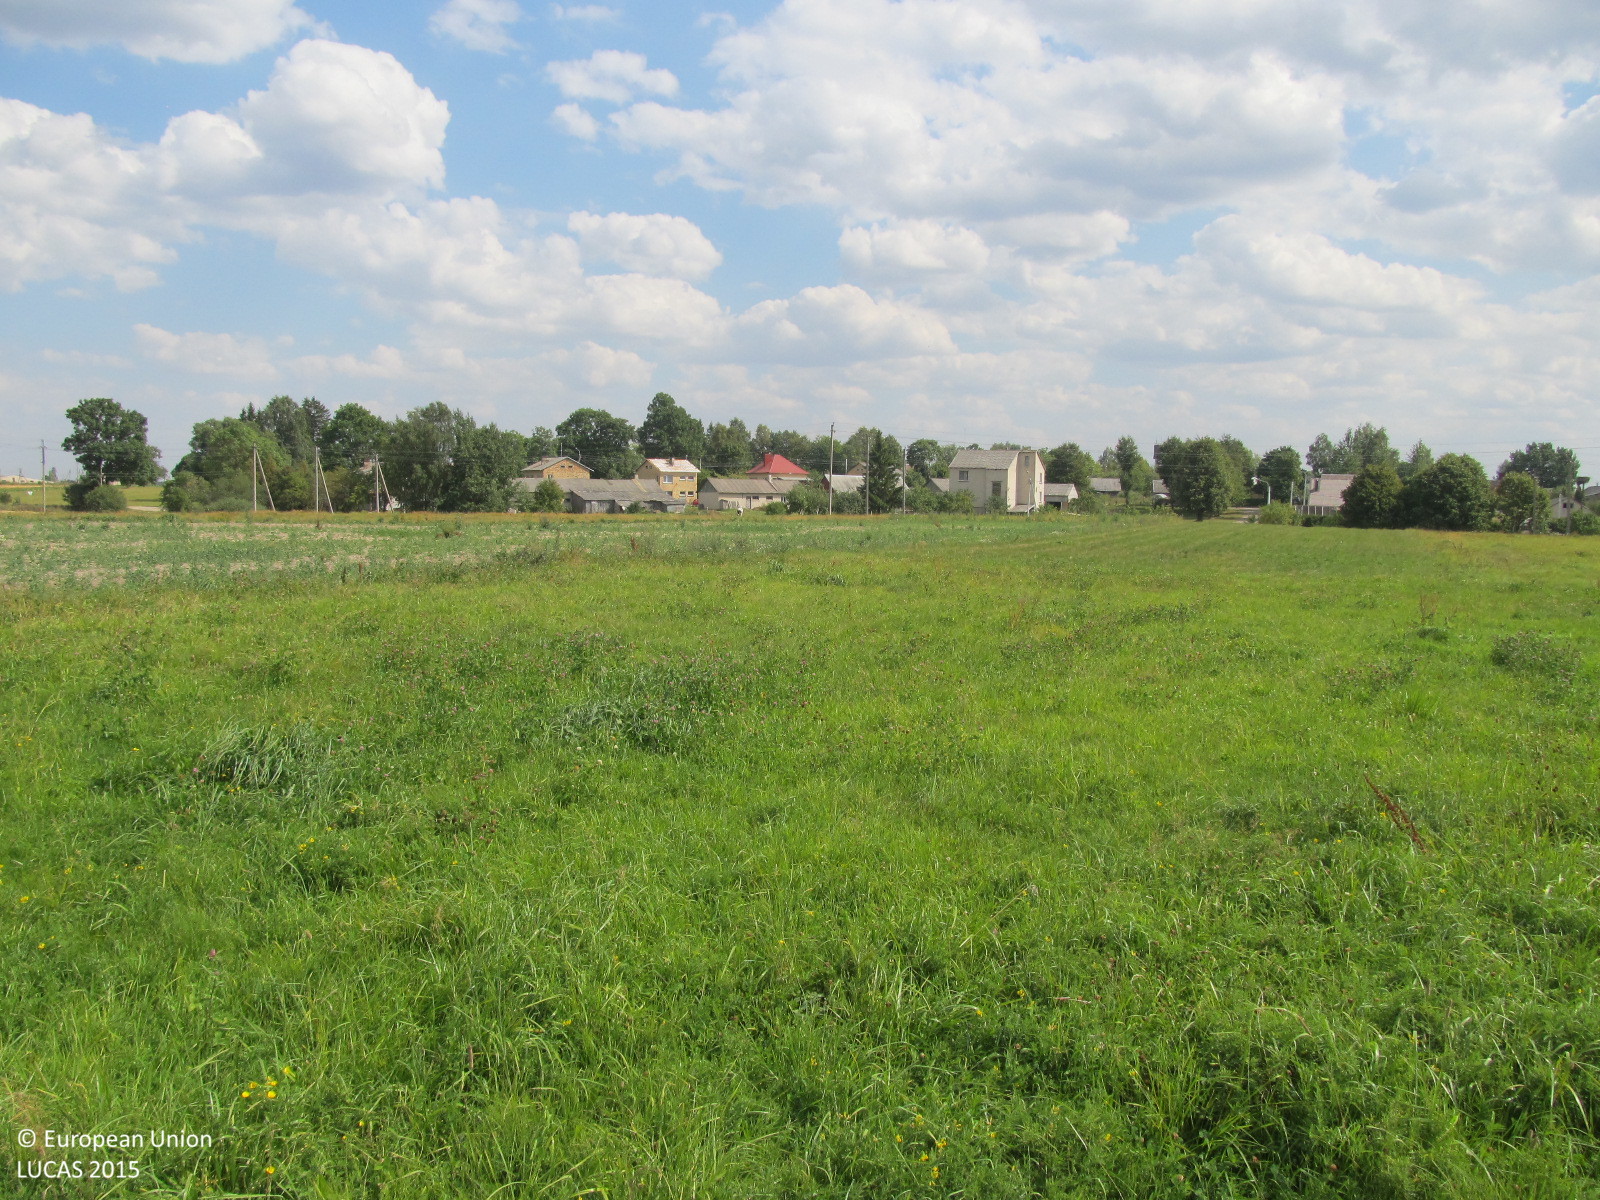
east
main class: Grassland
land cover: Grassland without tree/shrub cover
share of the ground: > 75 %
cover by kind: herbaceous plants 100 %
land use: Agriculture (excluding fallow land and kitchen gardens)
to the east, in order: Grassland without tree/shrub cover; Other bare soil; Grassland without tree/shrub cover; Electric lines; Grassland without tree/shrub cover; Electric lines; Grassland without tree/shrub cover; Other fresh vegetables; Electric lines; Other fresh vegetables; Grassland without tree/shrub cover; Ditches and canals; Grassland without tree/shrub cover; Artificial constructions in urban areas
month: August
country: LT
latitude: 55.8005
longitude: 23.1362
